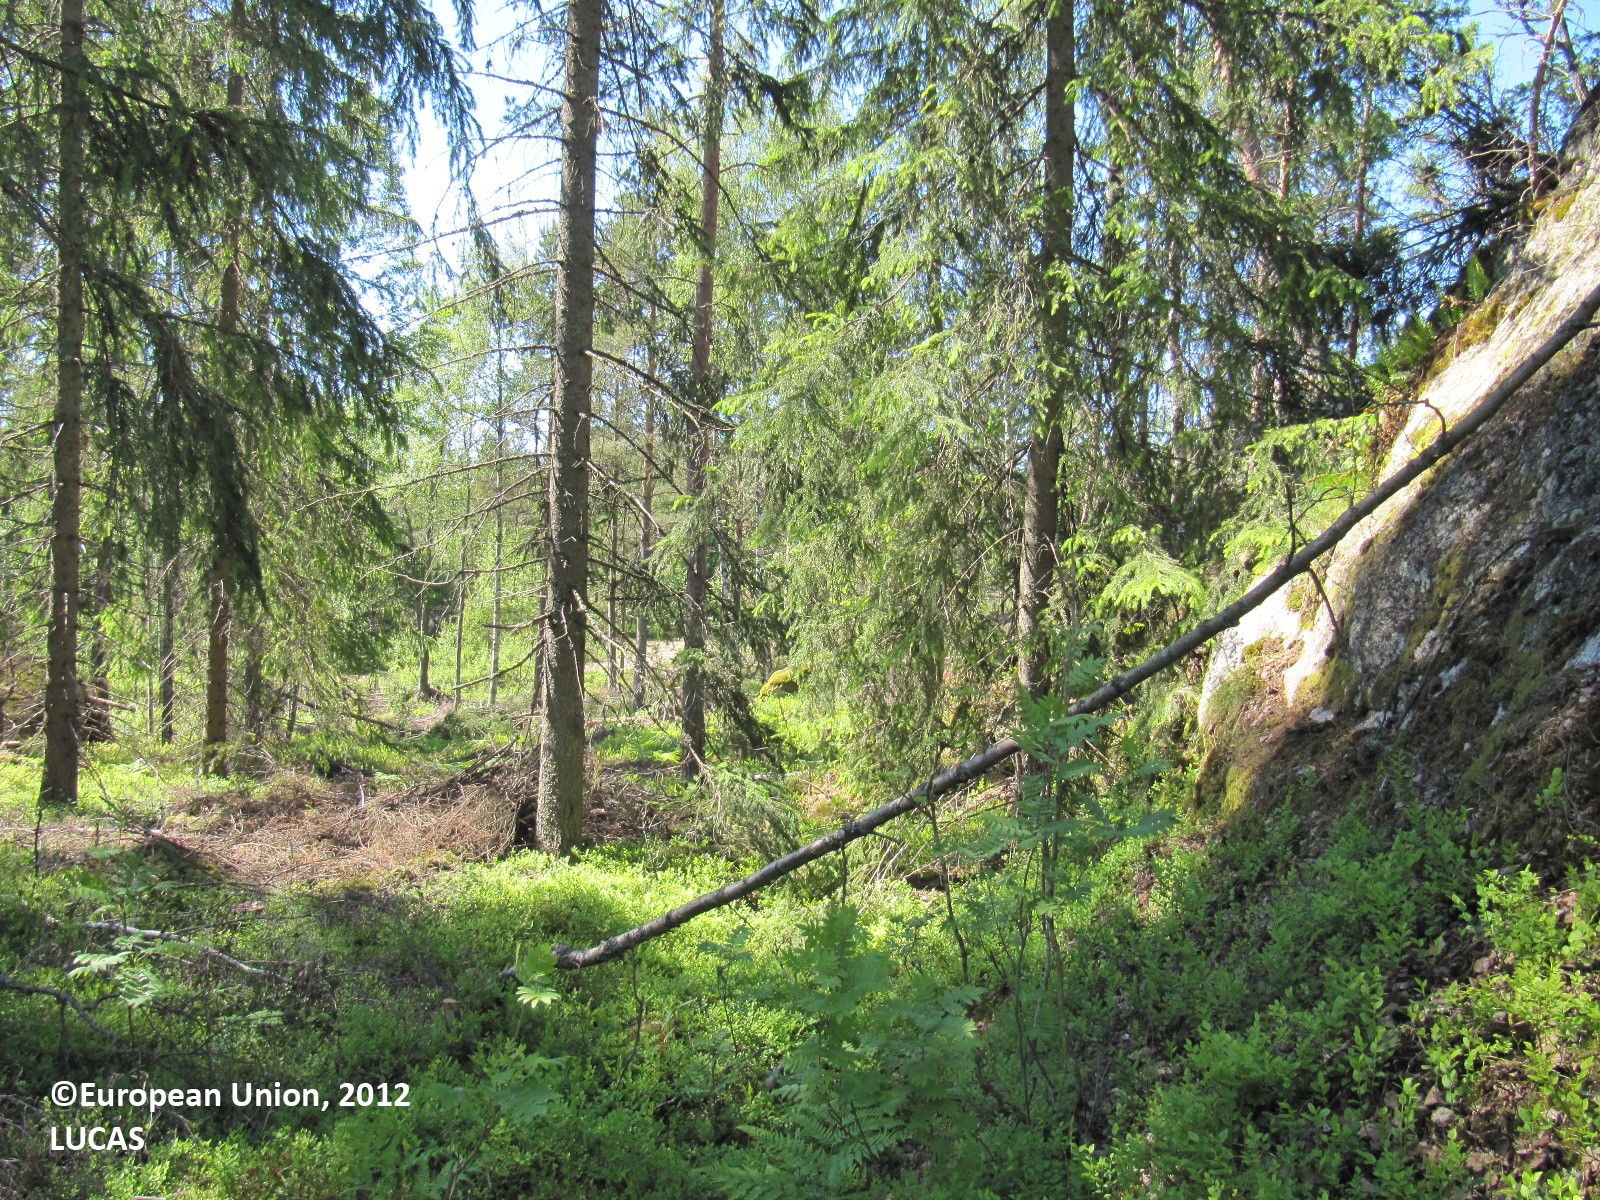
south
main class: Woodland
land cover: Pine dominated mixed woodland
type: boreal forest
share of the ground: 25 - 50 %
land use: Forestry
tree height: > 5 m
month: June
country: FI
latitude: 60.1495
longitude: 24.2424
